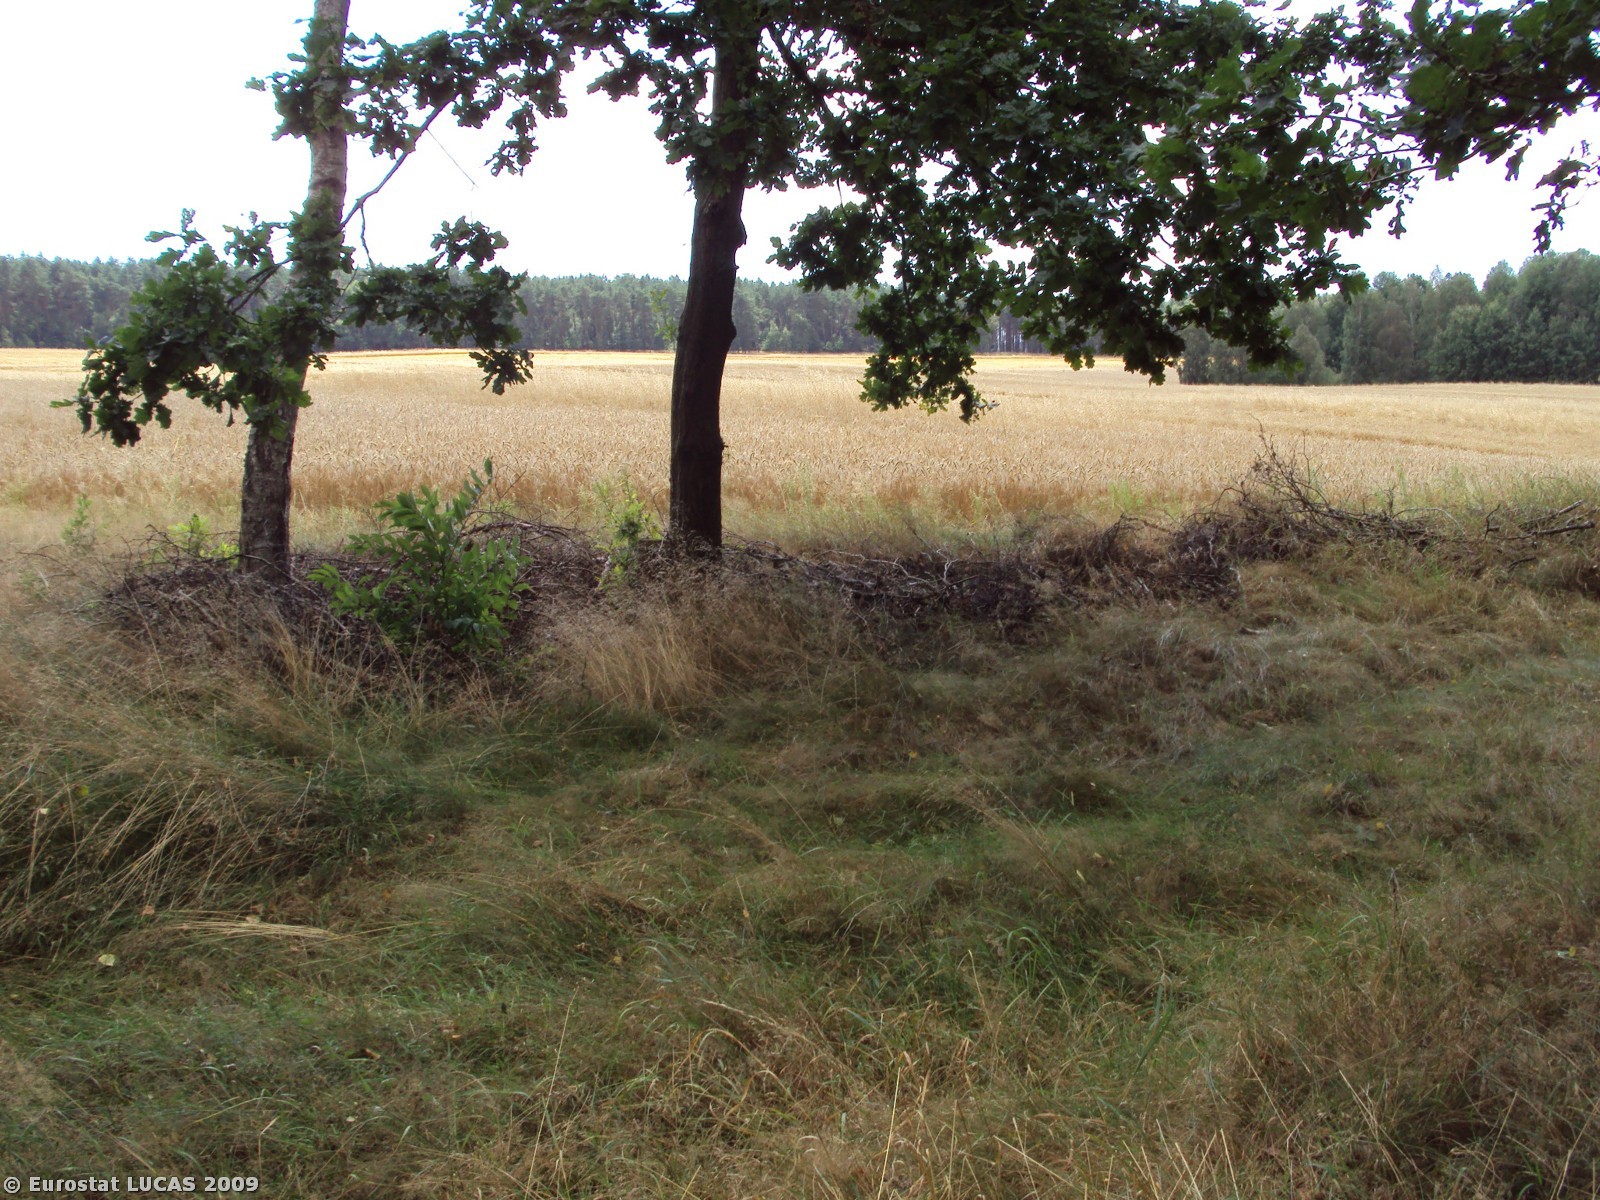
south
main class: Woodland
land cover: Broadleaved woodland
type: mesophytic deciduous forest
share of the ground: > 75 %
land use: Forestry
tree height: > 5 m
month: August
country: PL
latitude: 53.4881
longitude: 15.9881
